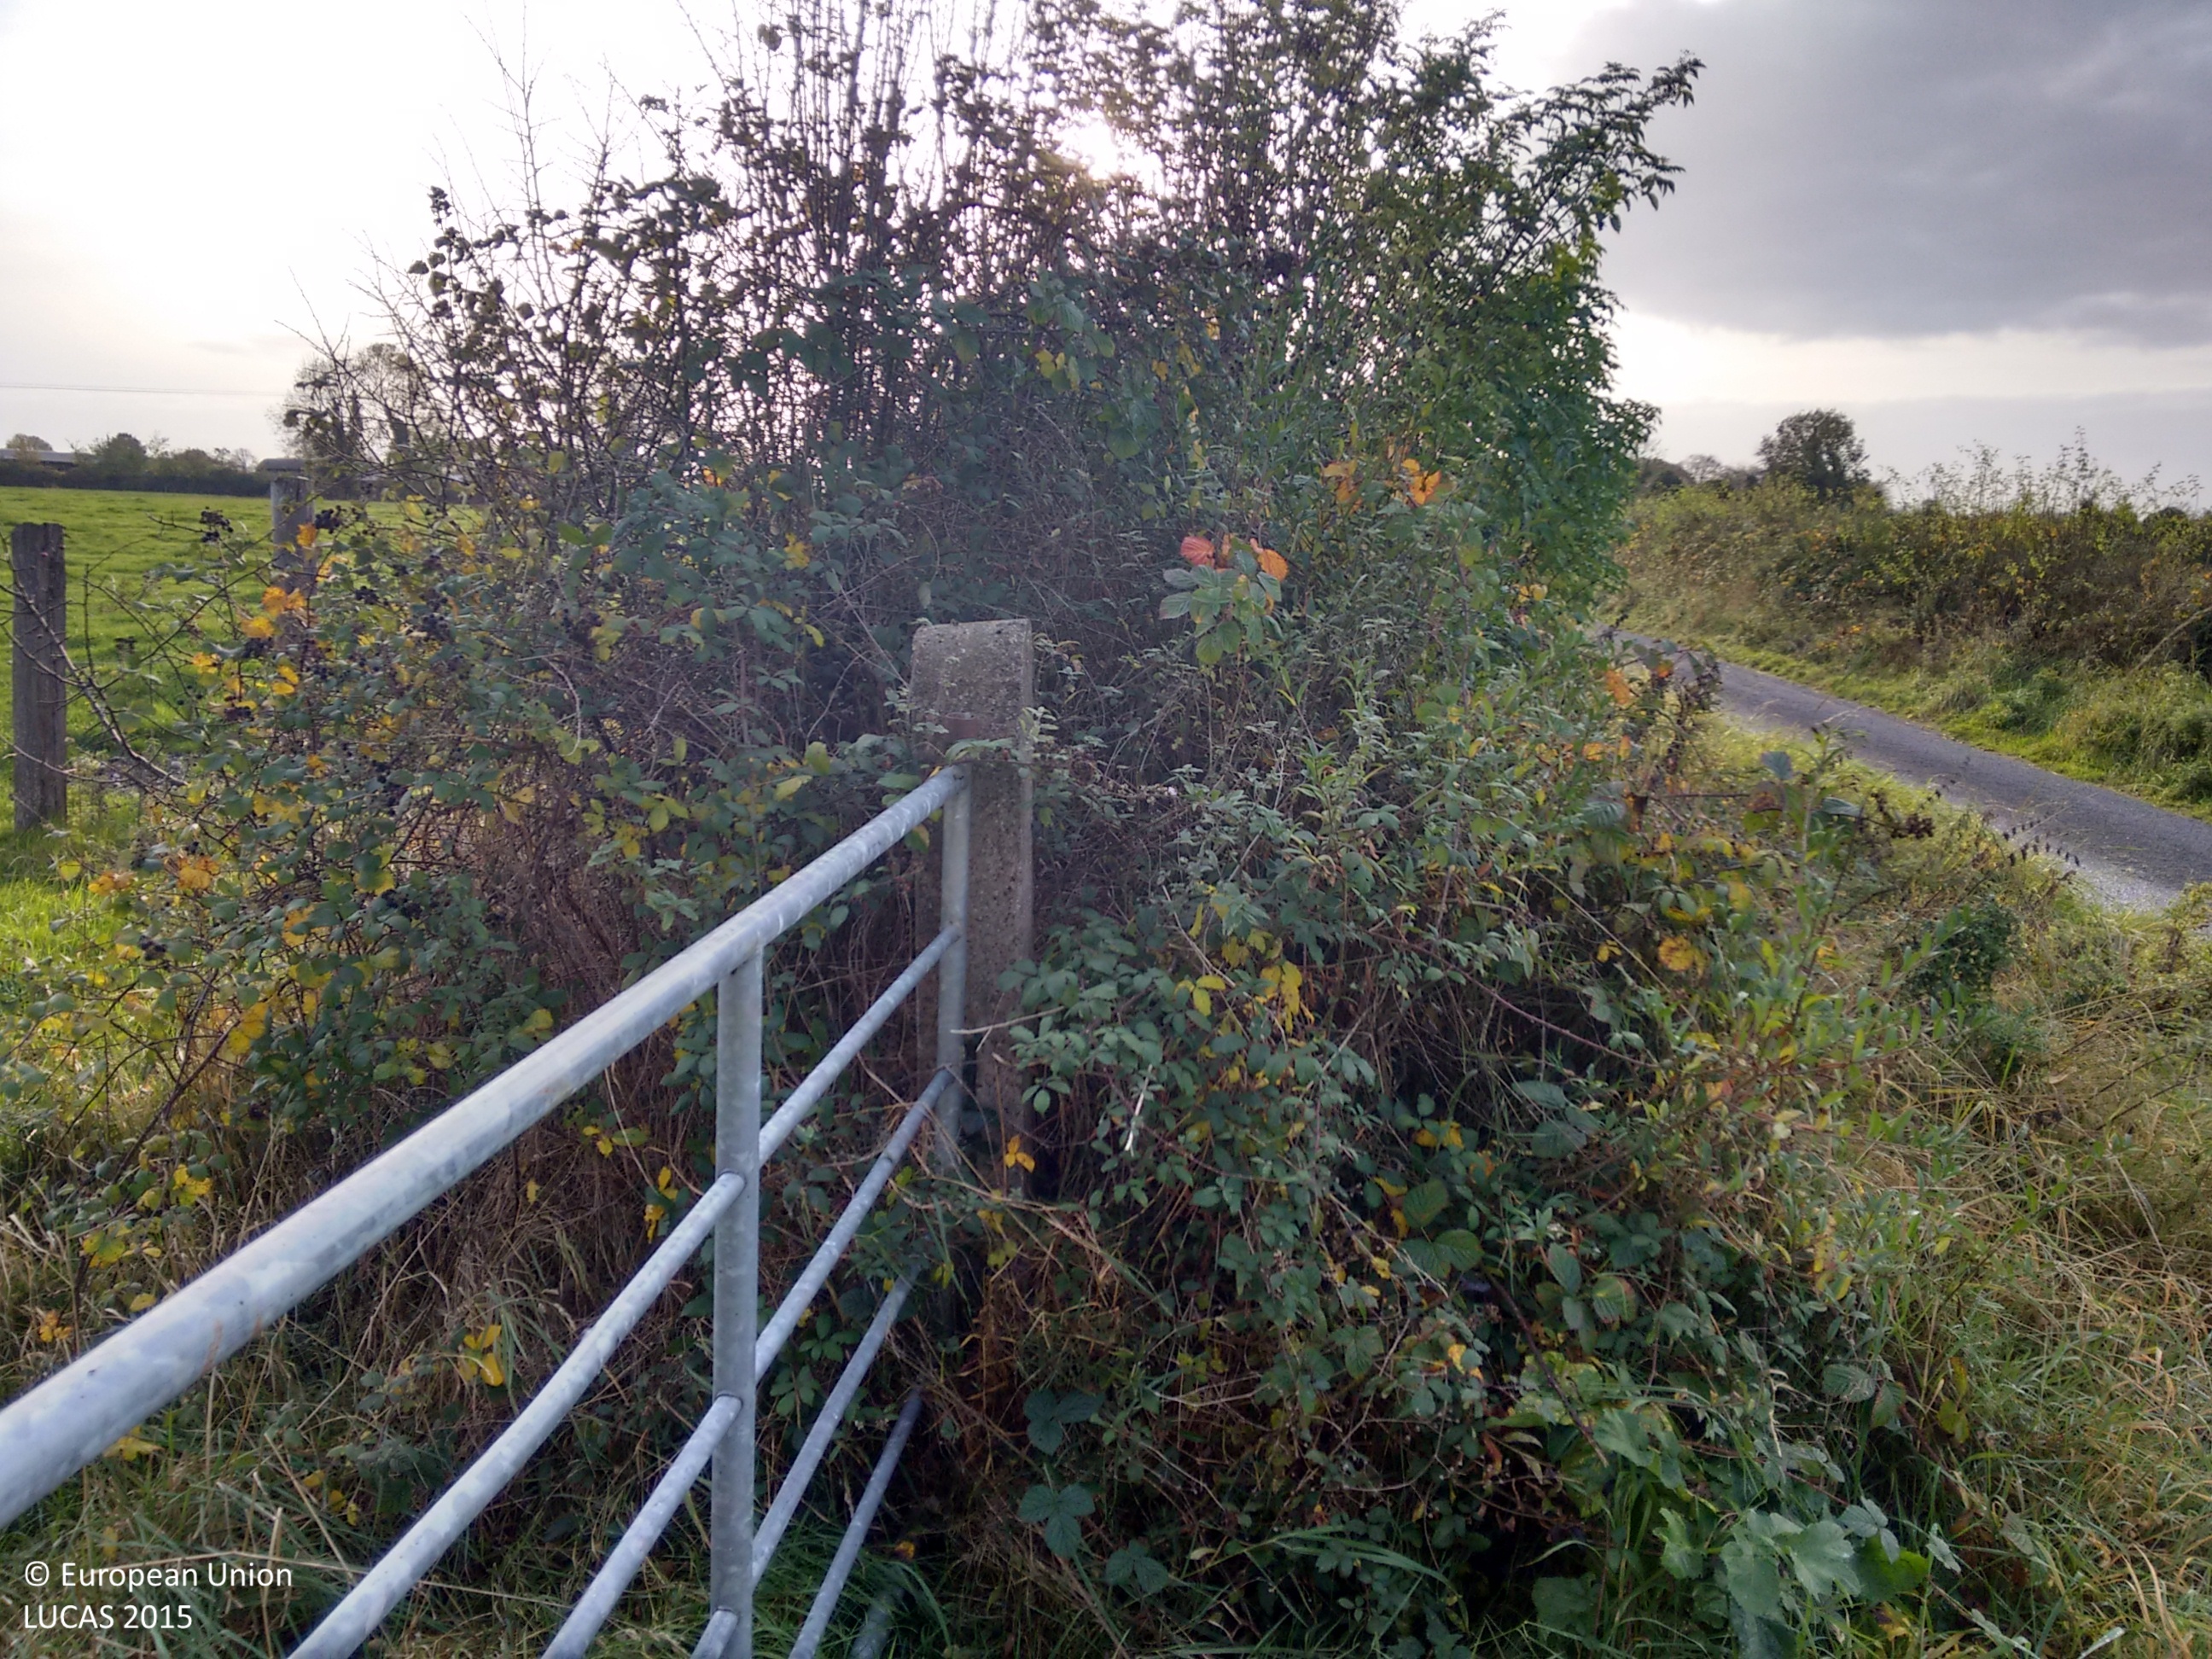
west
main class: Grassland
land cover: Grassland without tree/shrub cover
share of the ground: > 75 %
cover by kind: herbaceous plants 100 %
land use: Agriculture (excluding fallow land and kitchen gardens)
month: October
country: IE
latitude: 53.1684
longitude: -7.7124
